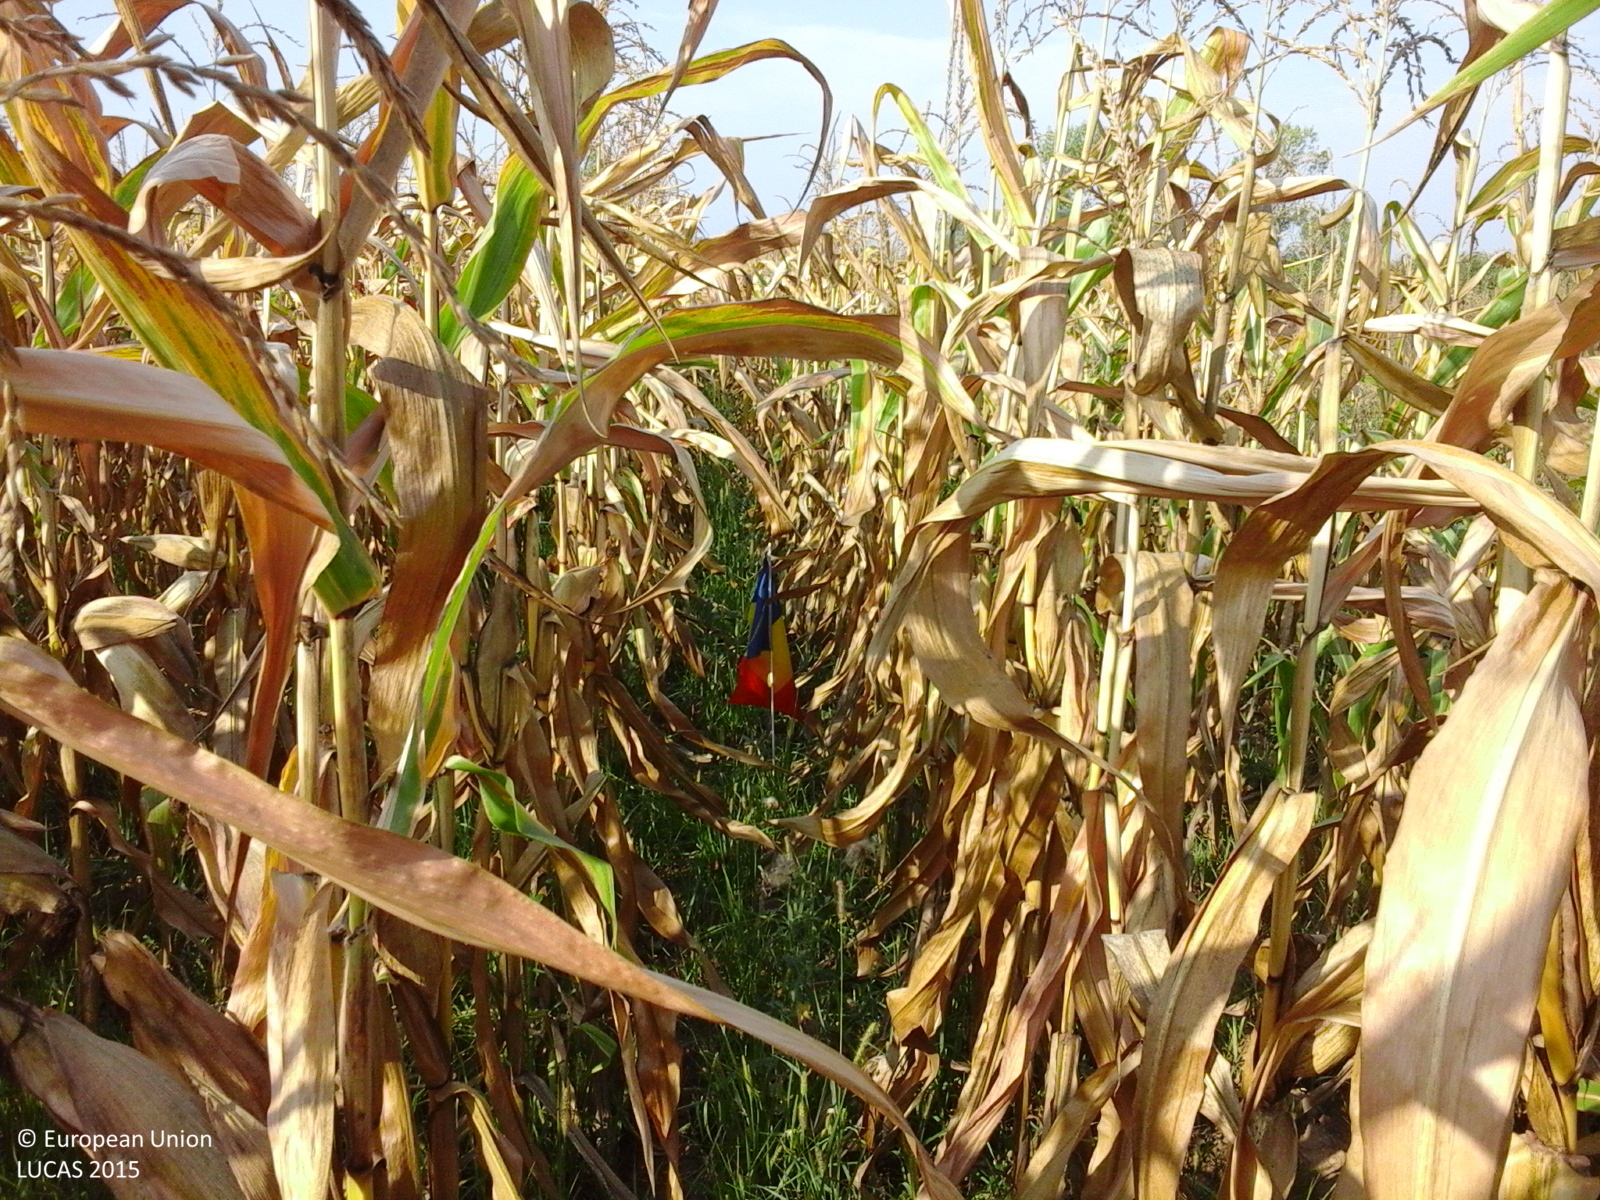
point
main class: Cropland
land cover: Maize
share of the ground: > 75 %
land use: Agriculture (excluding fallow land and kitchen gardens)
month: August
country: RO
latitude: 46.3719
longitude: 22.0957
